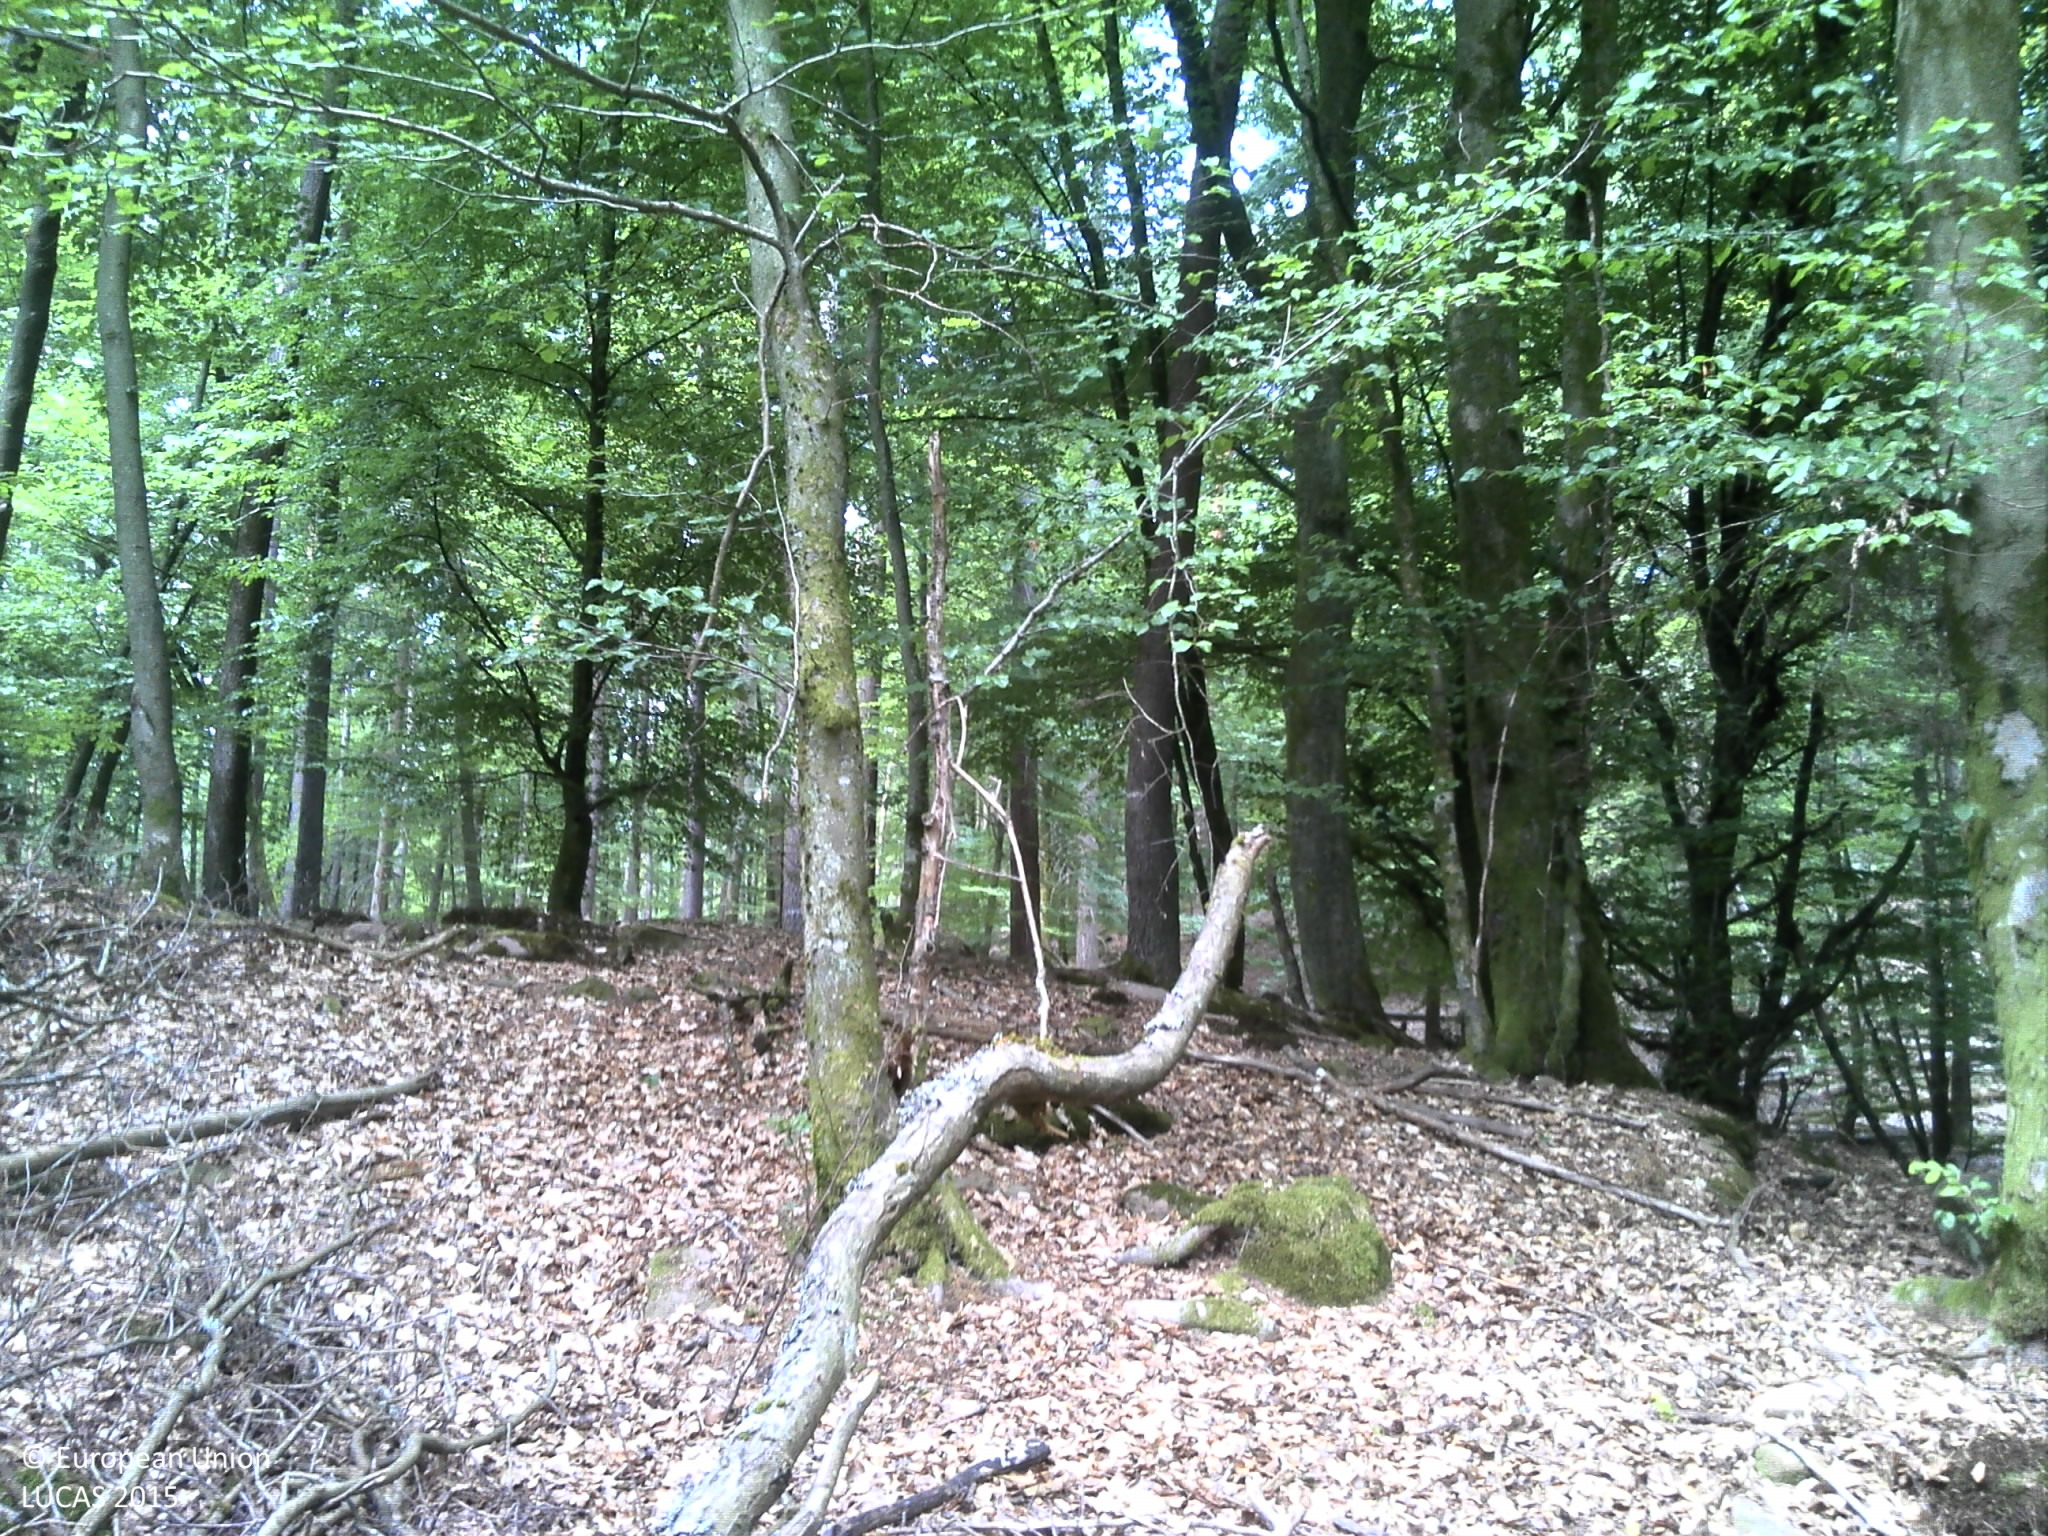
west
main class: Woodland
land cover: Broadleaved woodland
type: mesophytic deciduous forest
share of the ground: > 75 %
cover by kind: broadleaved forest trees 85 %, coniferous forest trees 5 %, lichens and mosses 5 %, unconsolidated bare surface 5 %
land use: Forestry
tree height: > 5 m
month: July
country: FR
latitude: 48.9866
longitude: 7.4725
